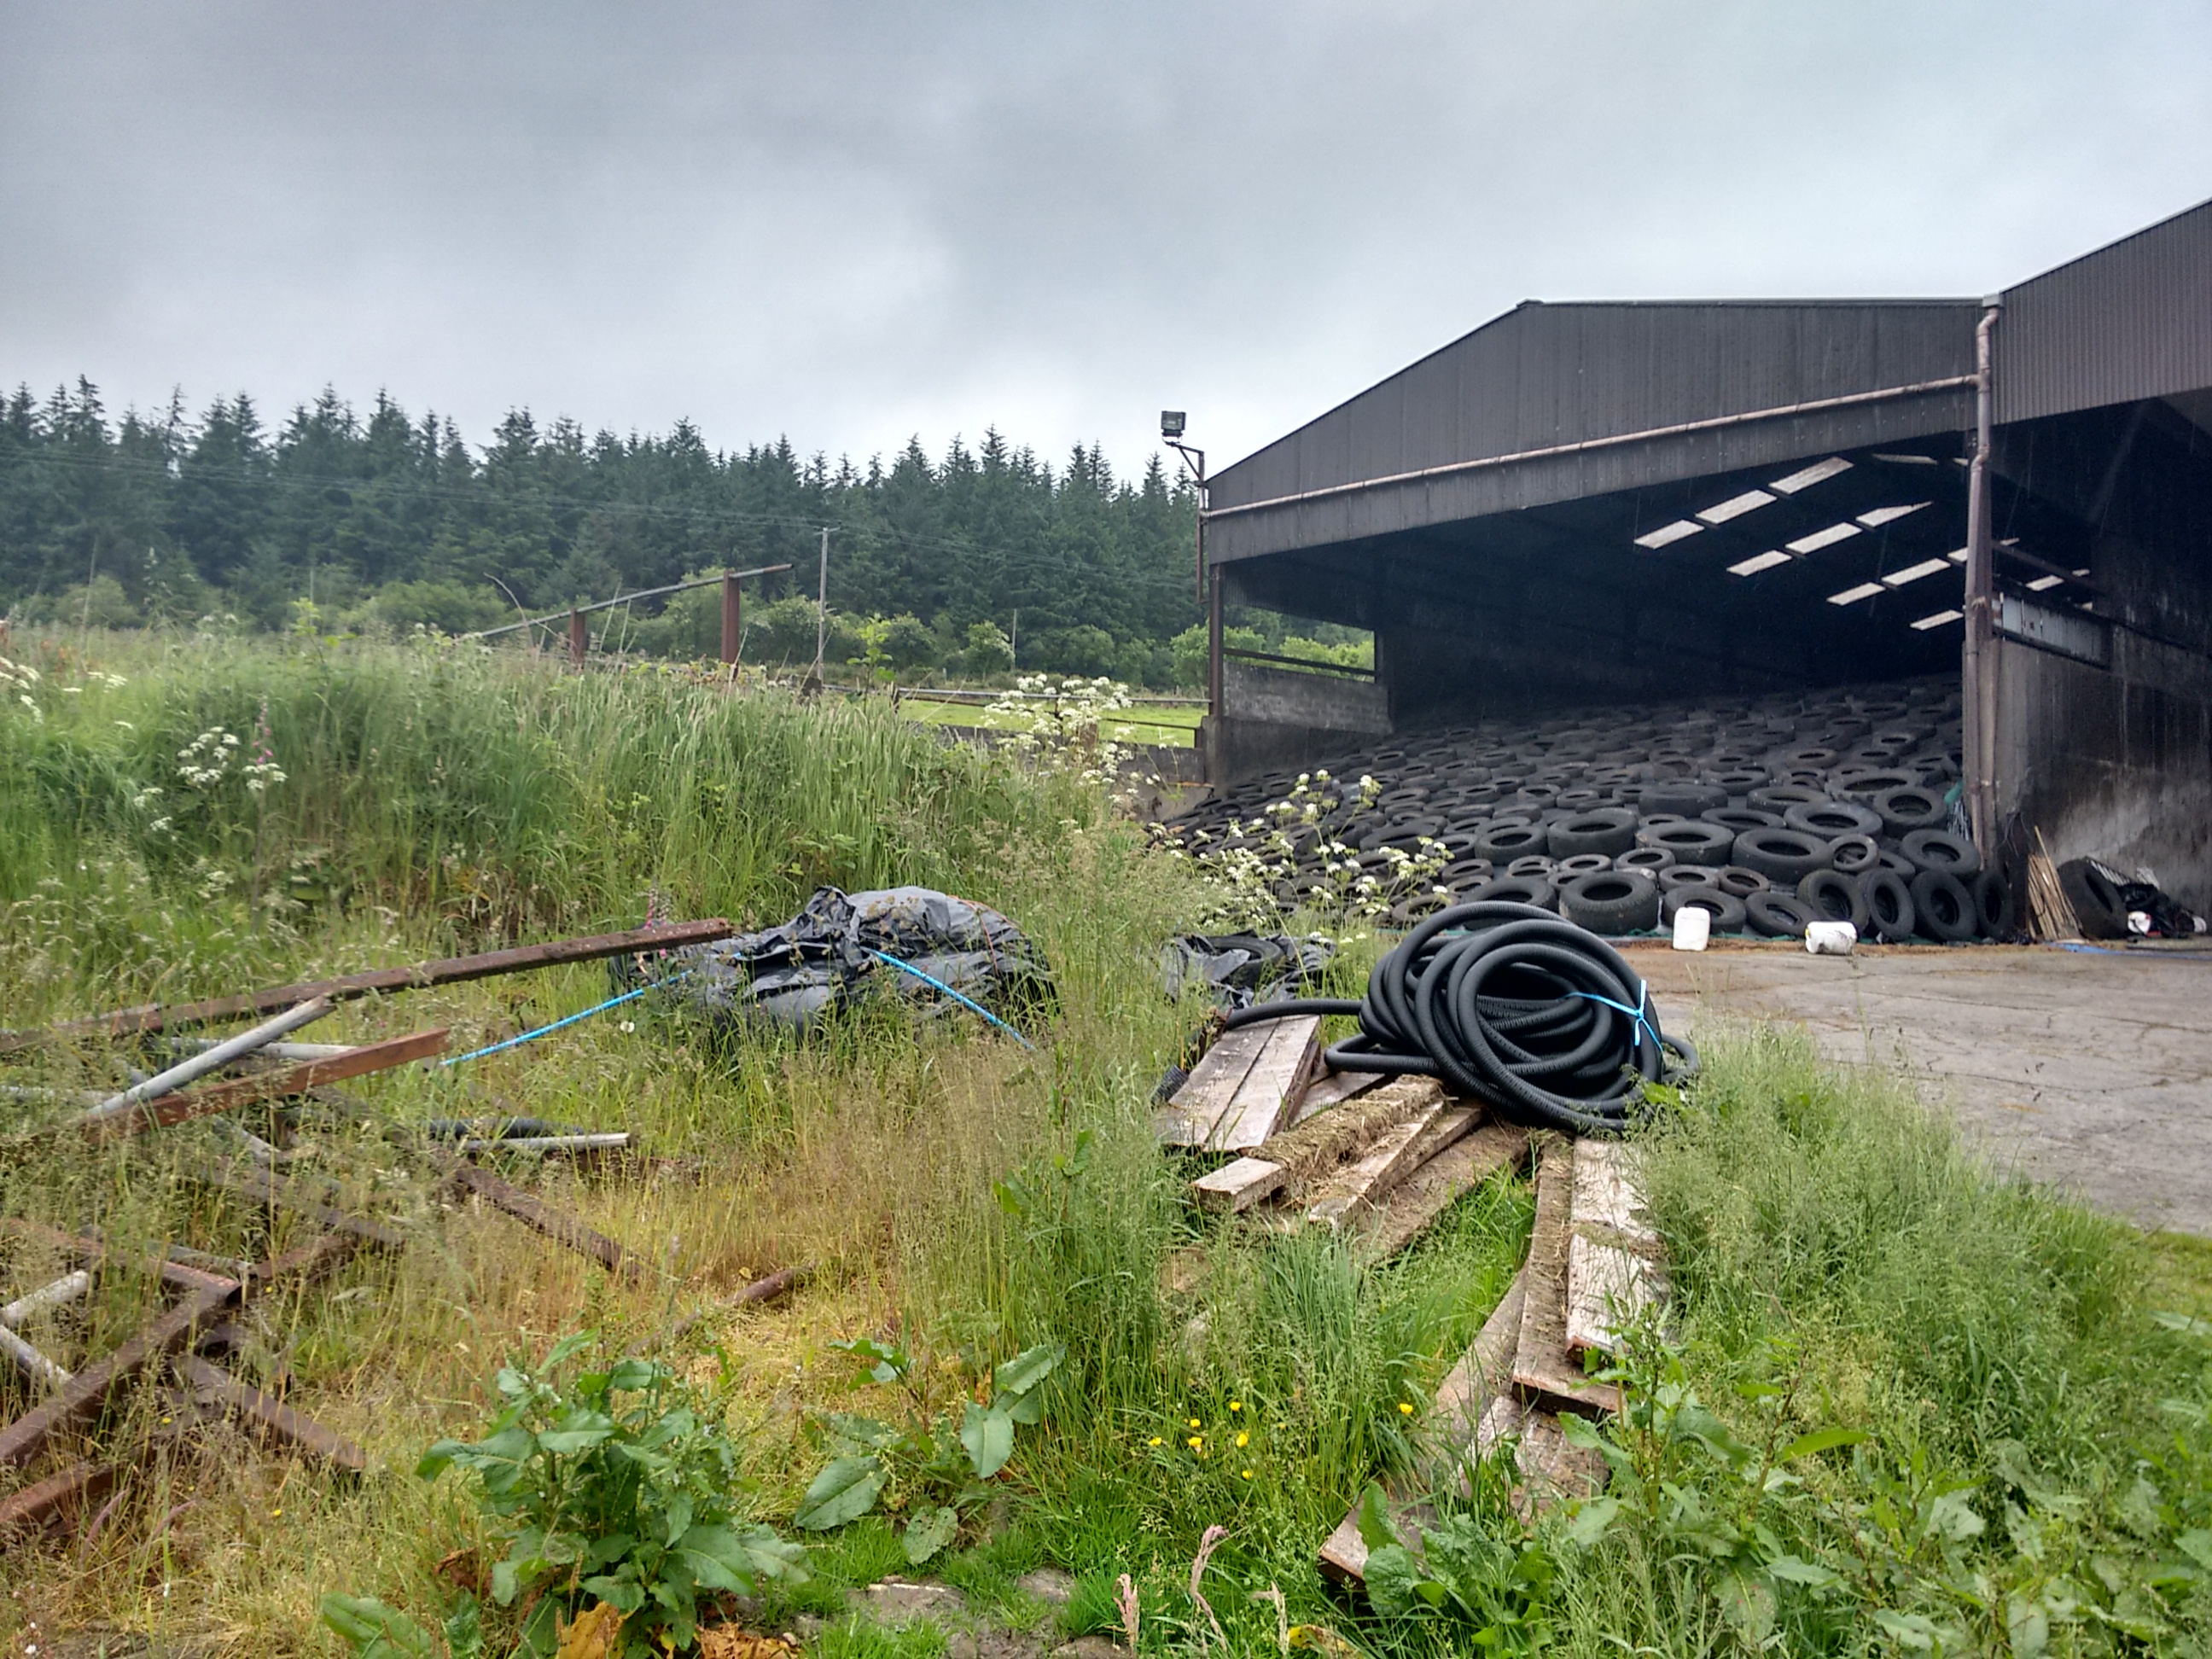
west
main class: Grassland
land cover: Grassland without tree/shrub cover
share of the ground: > 75 %
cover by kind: herbaceous plants 100 %
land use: Agriculture (excluding fallow land and kitchen gardens)
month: June
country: GB
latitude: 54.6783
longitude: -7.4781
